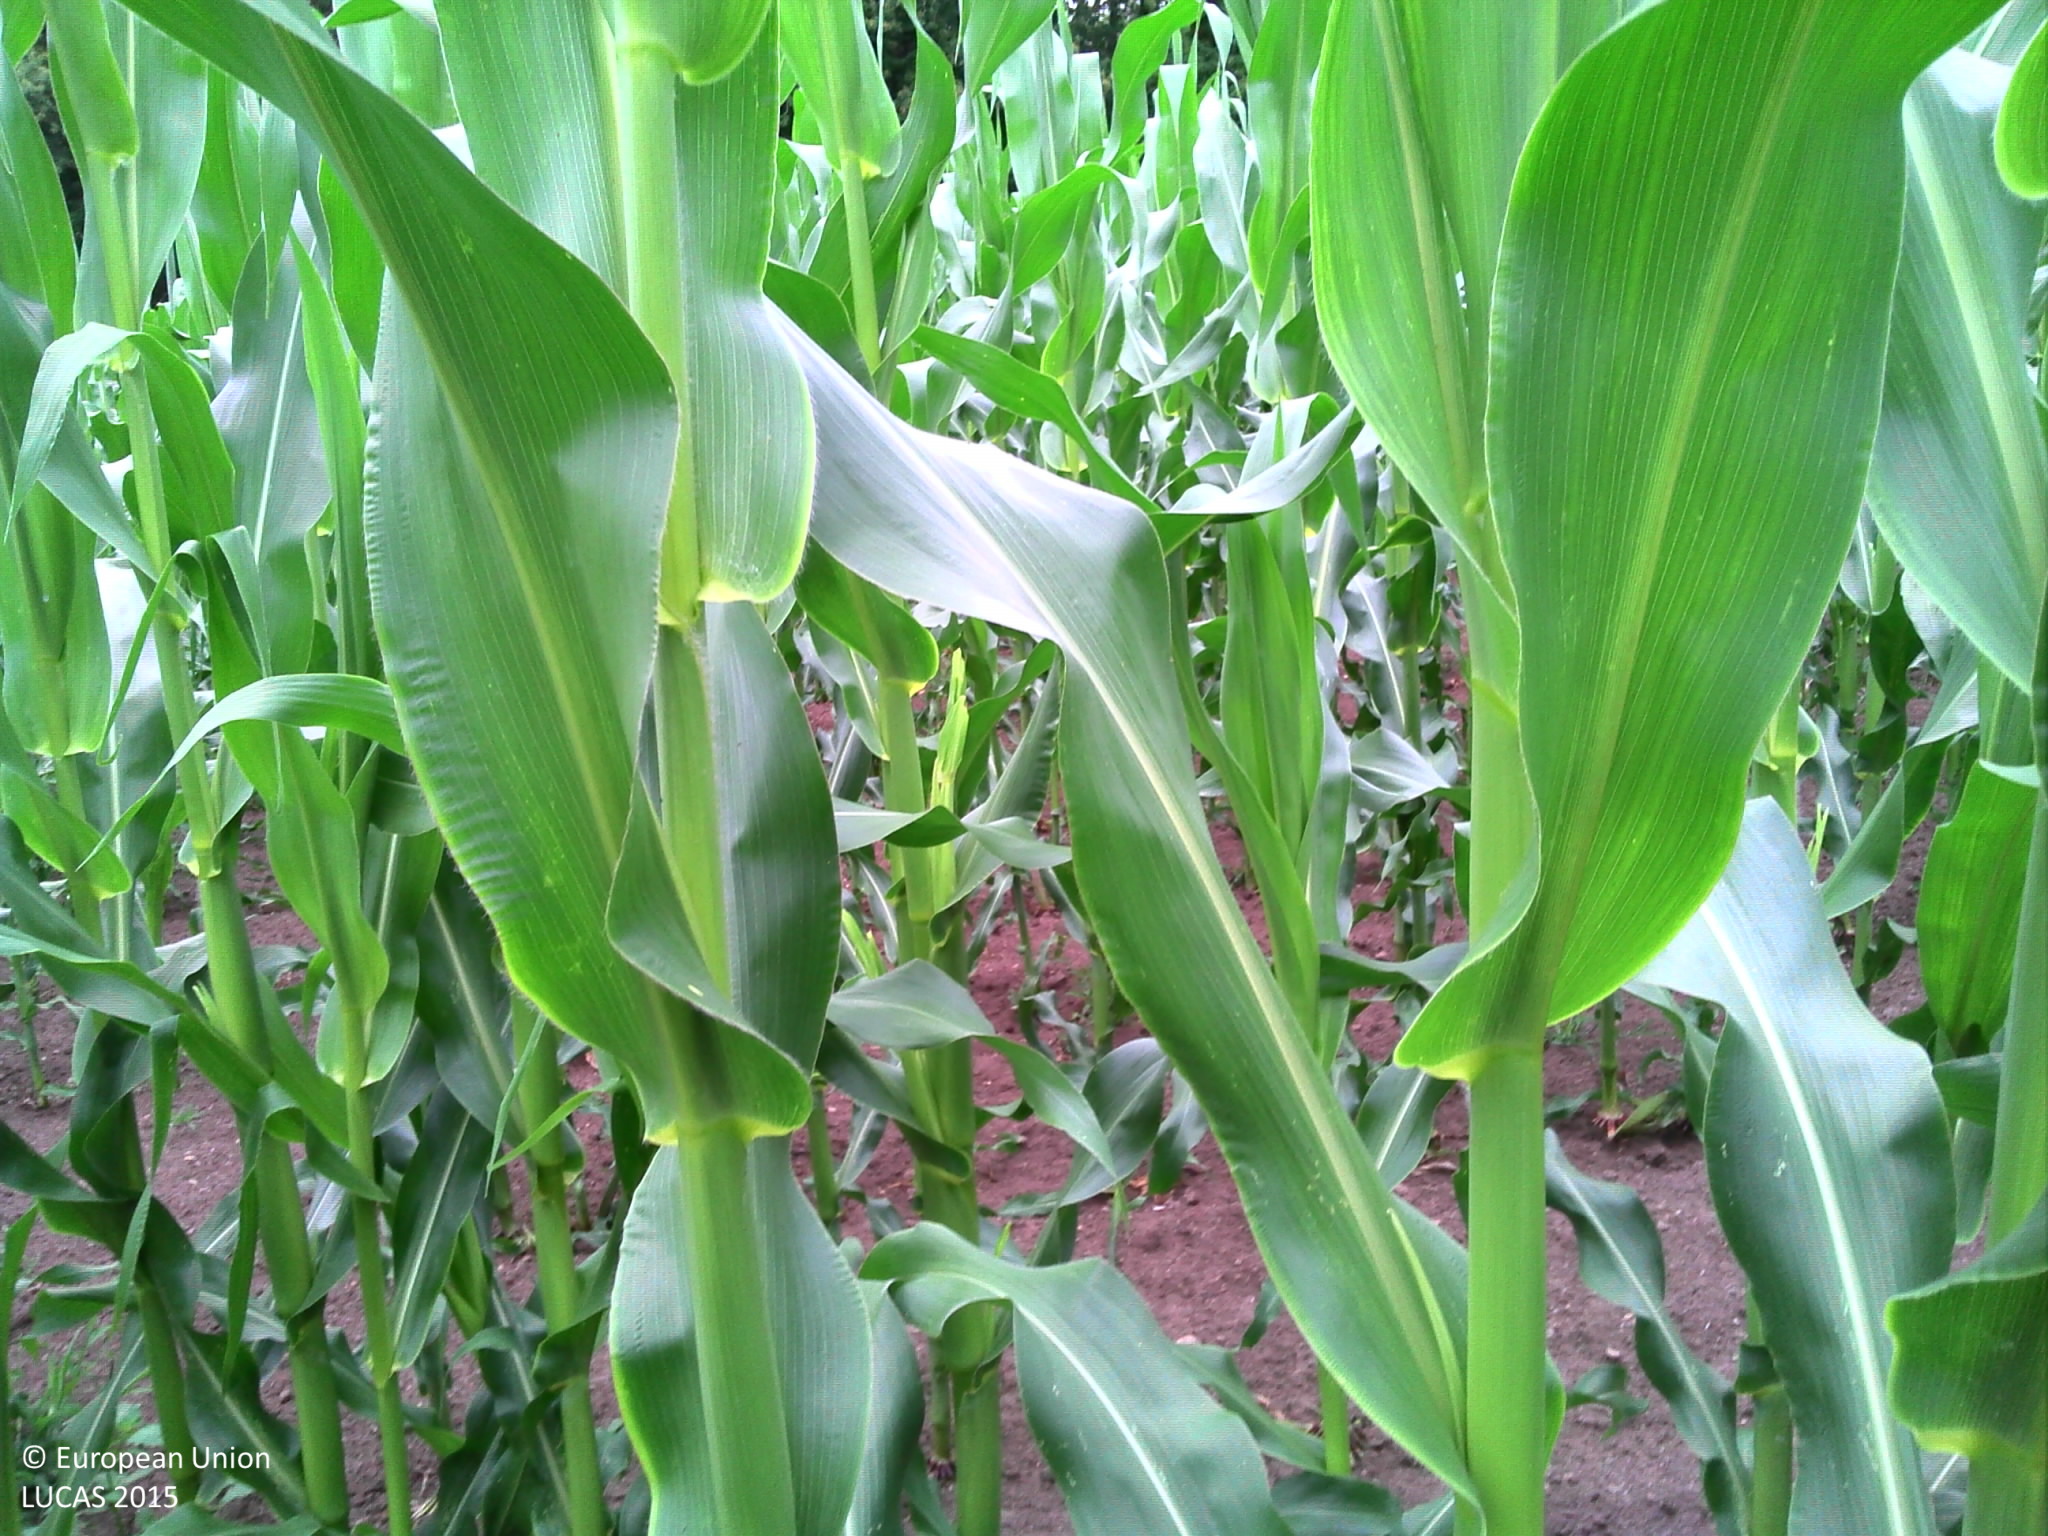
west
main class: Cropland
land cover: Maize
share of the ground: > 75 %
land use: Agriculture (excluding fallow land and kitchen gardens)
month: July
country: FR
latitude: 47.7462
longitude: -3.2617
